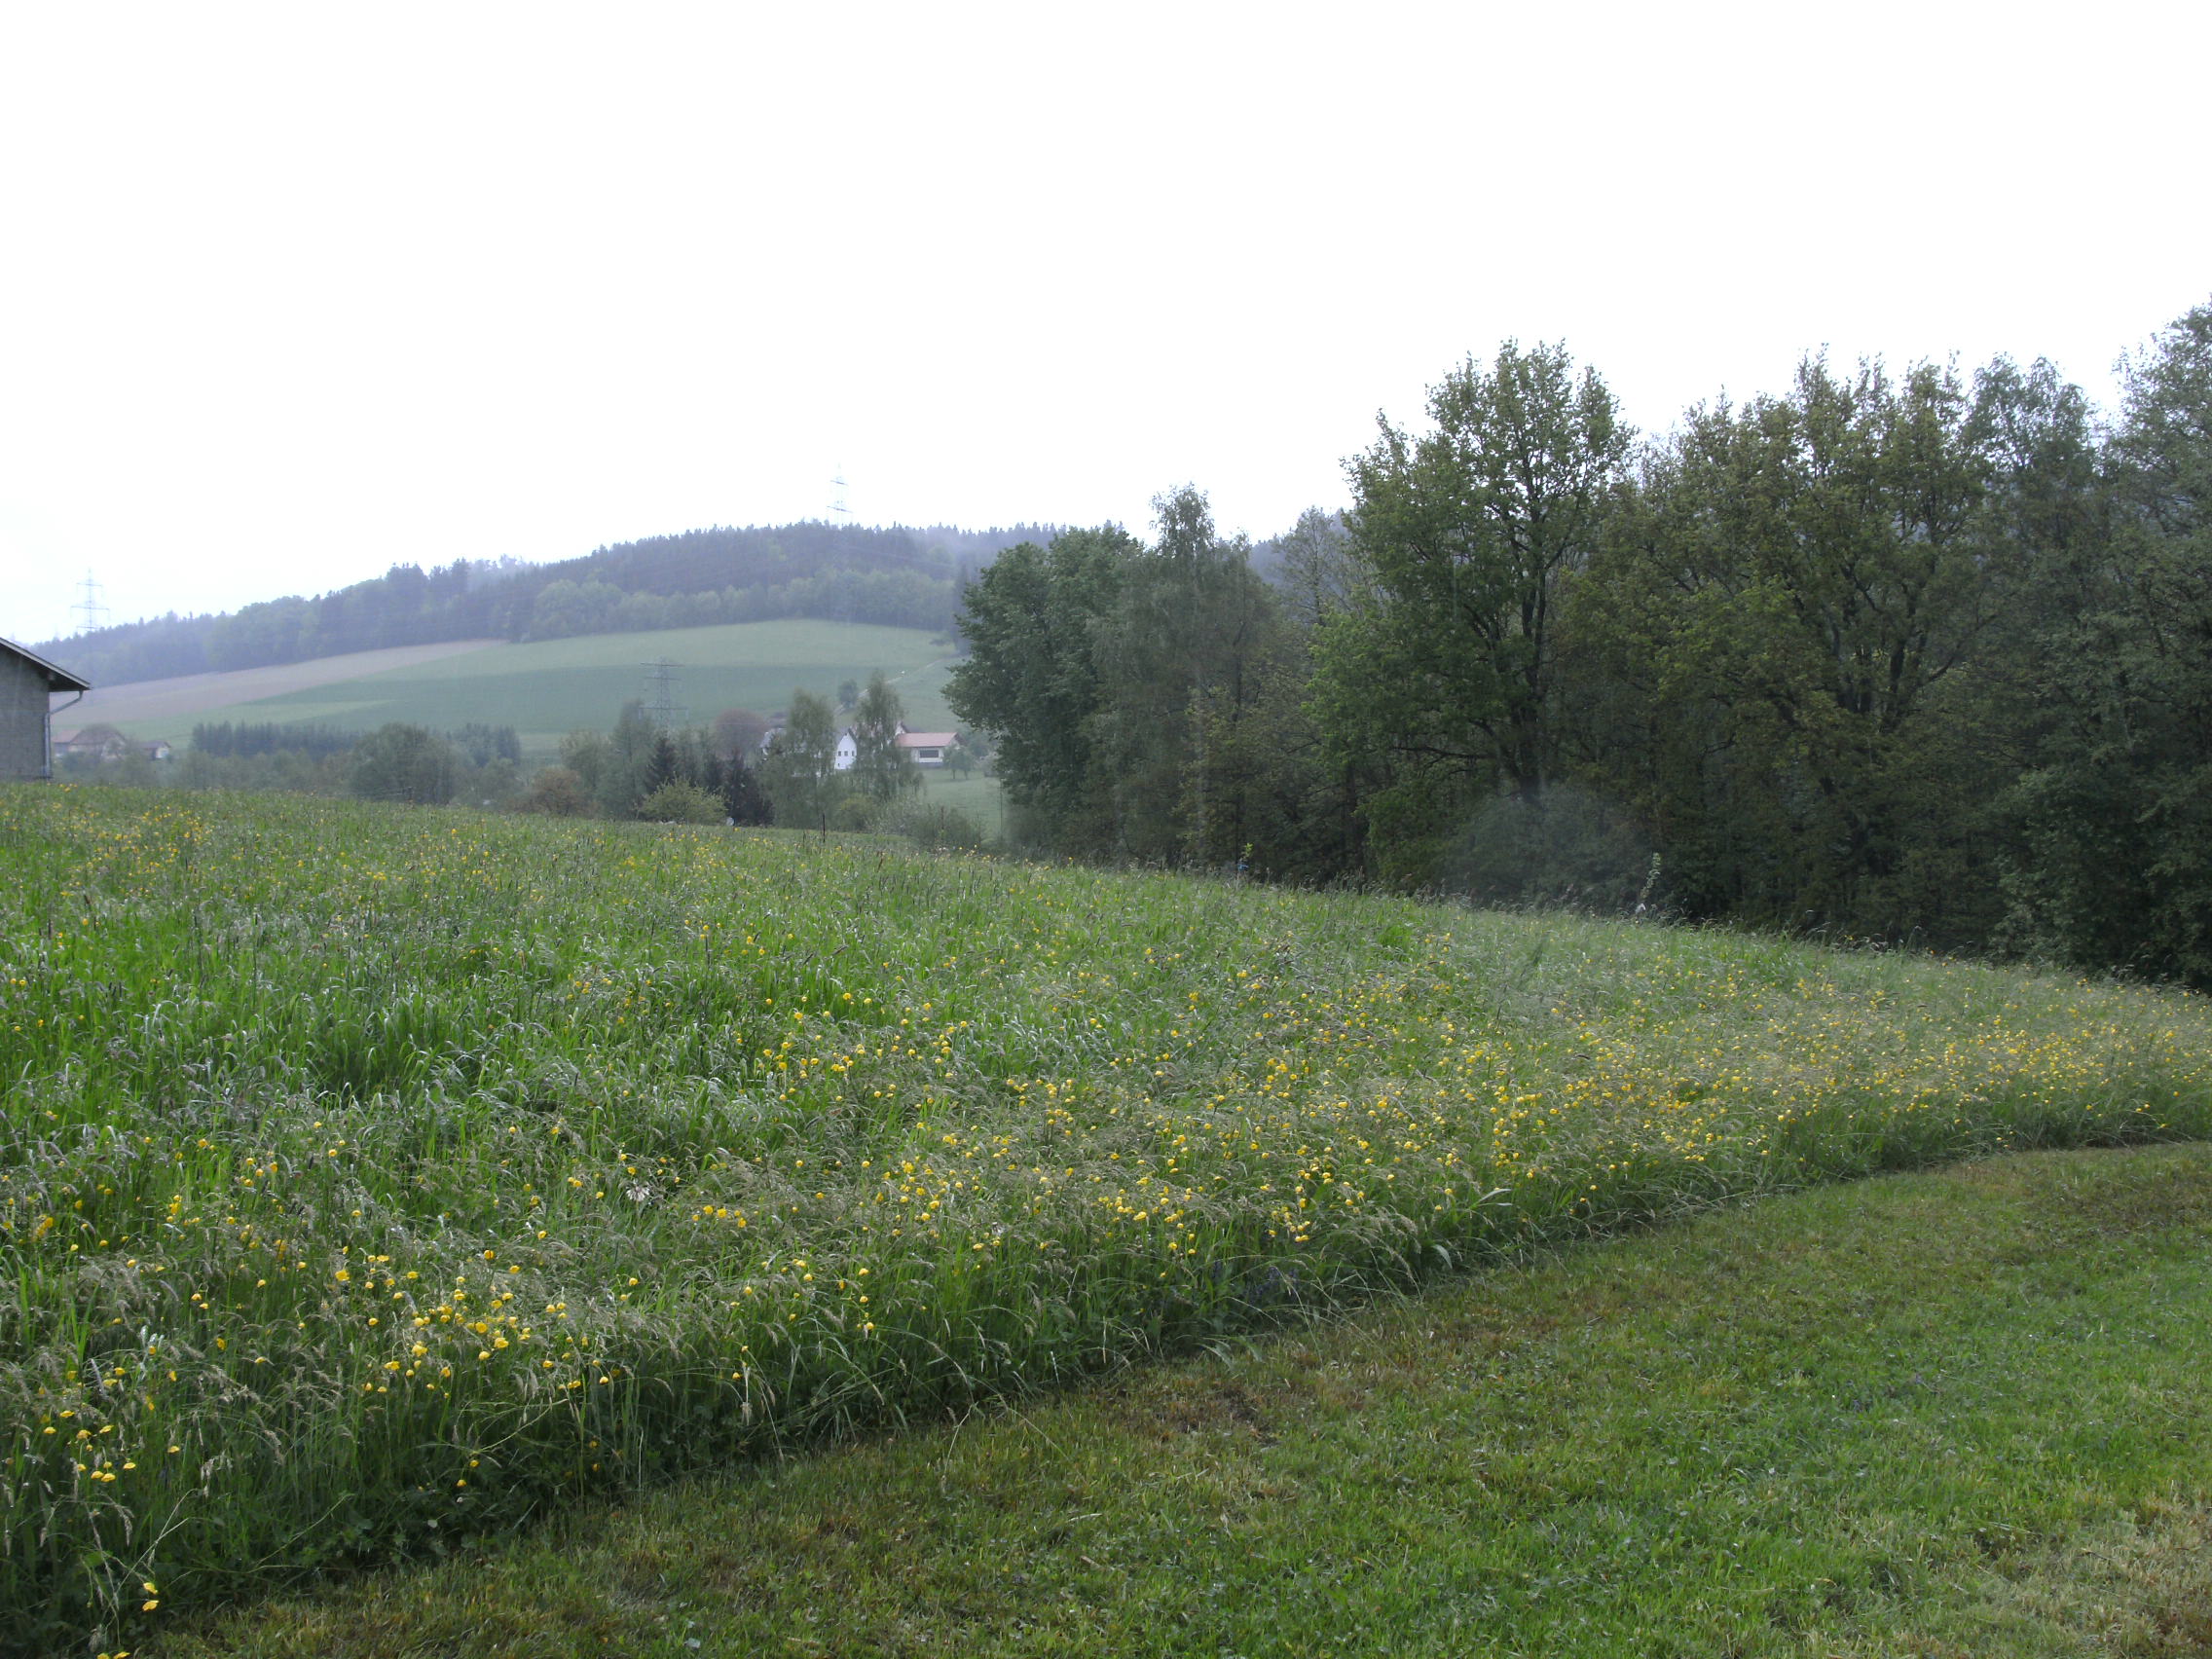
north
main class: Grassland
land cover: Grassland without tree/shrub cover
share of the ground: > 75 %
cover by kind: herbaceous plants 100 %
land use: Agriculture (excluding fallow land and kitchen gardens)
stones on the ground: < 10 %
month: May
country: AT
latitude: 48.2259
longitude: 13.3780
